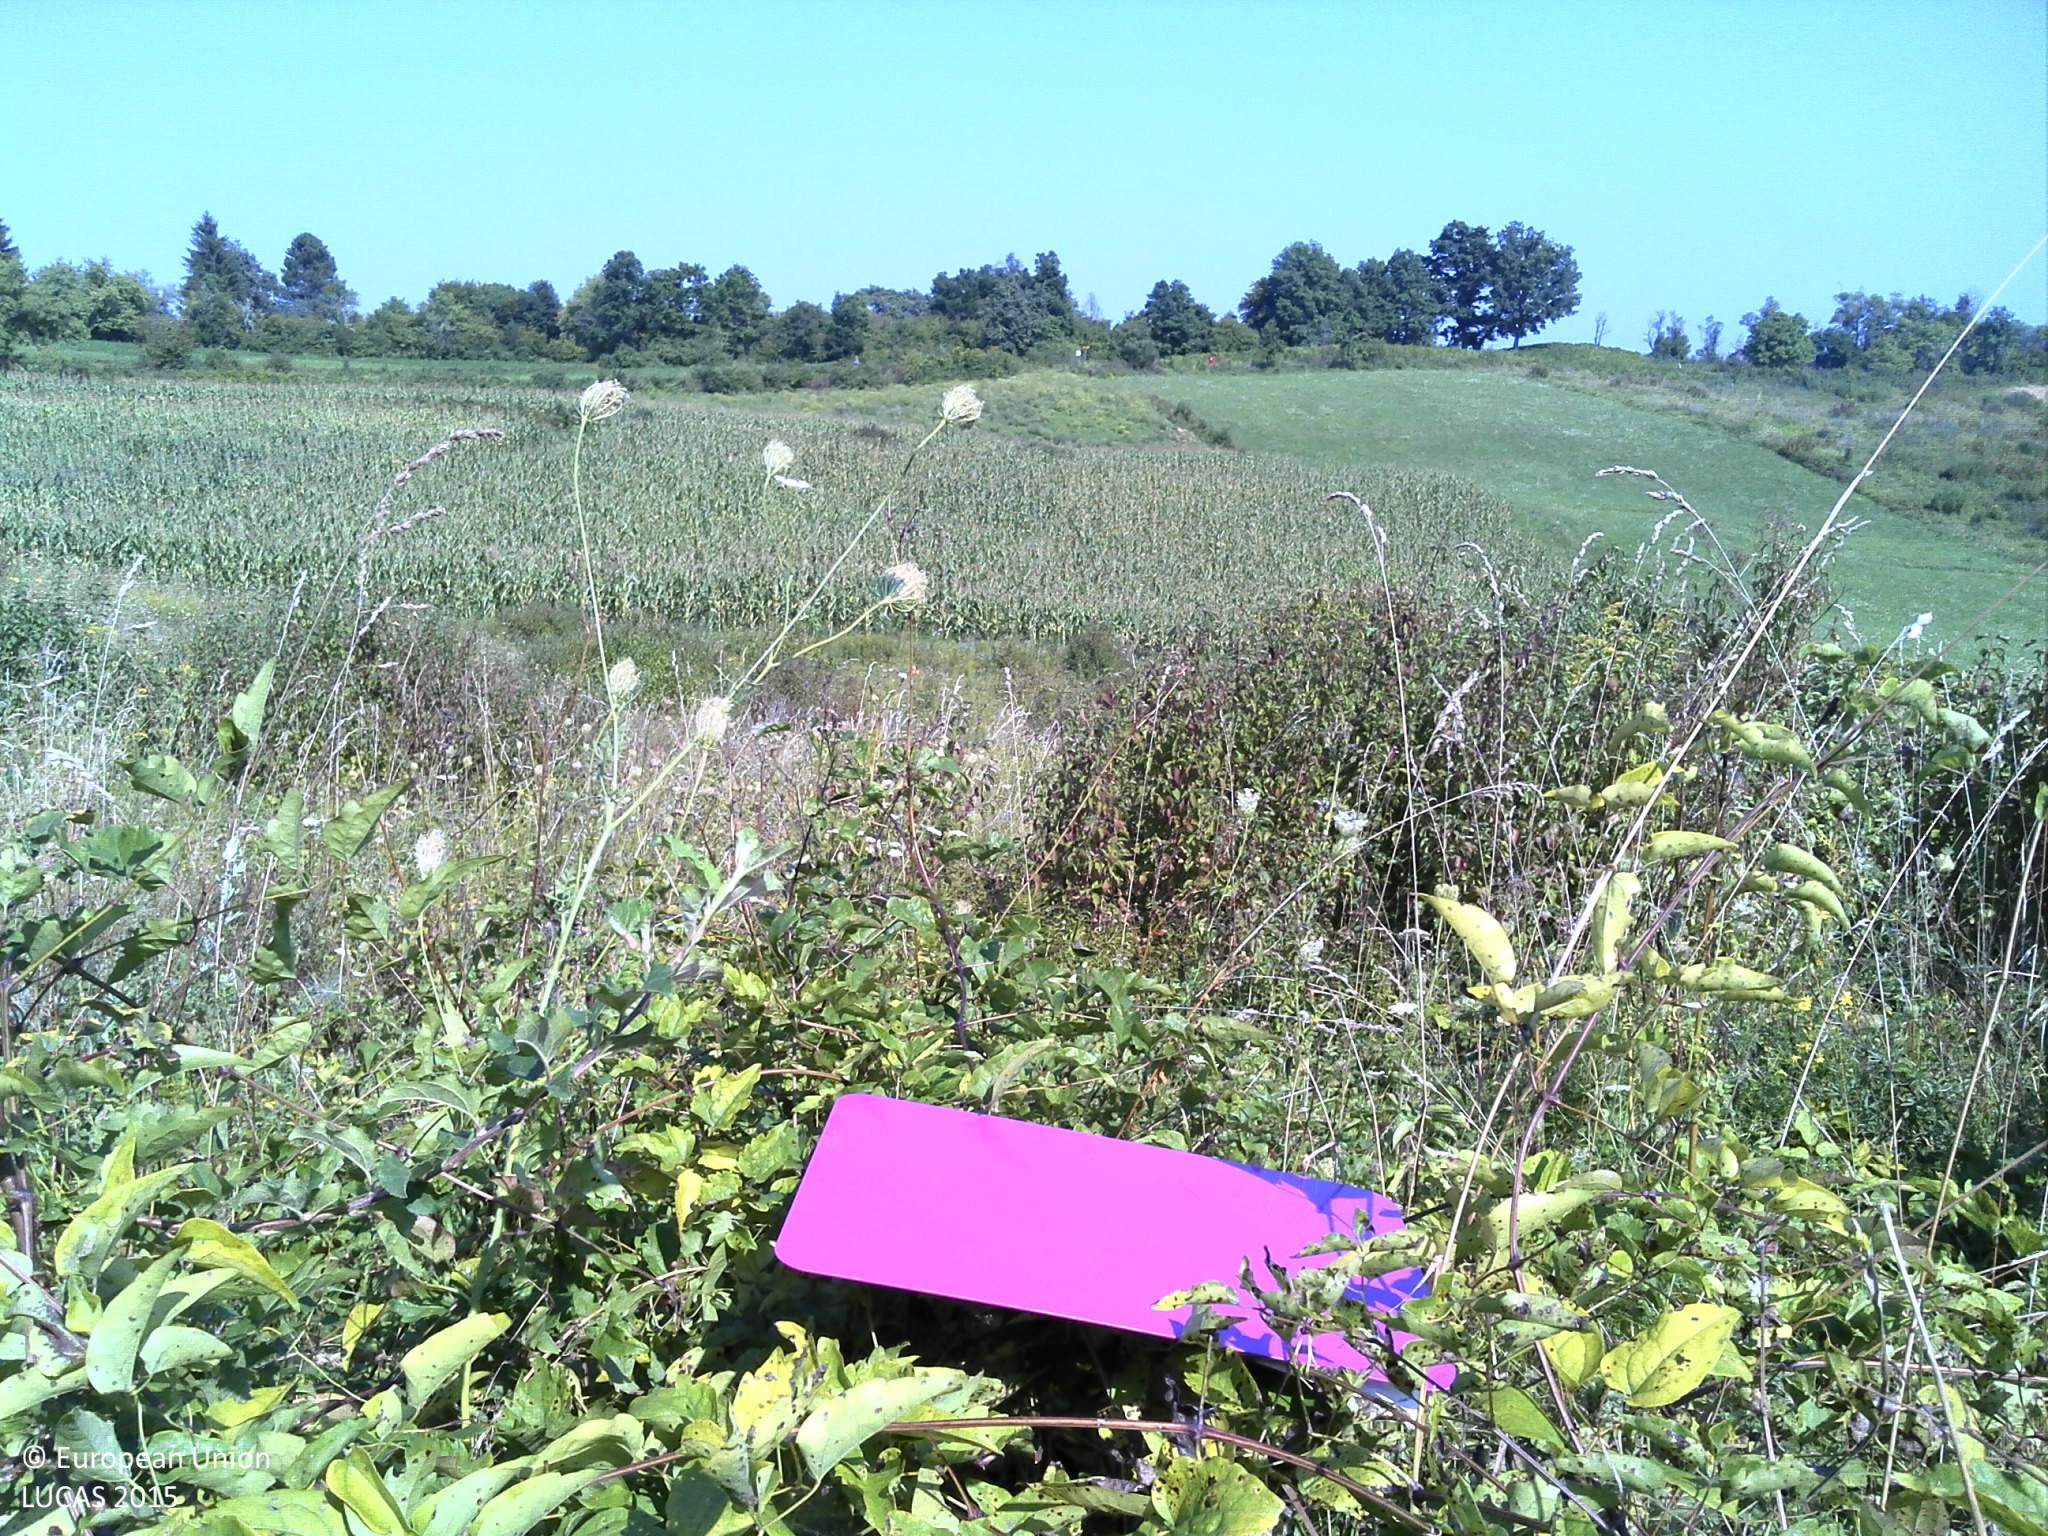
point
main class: Grassland
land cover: Spontaneously vegetated surfaces
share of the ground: > 75 %
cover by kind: herbaceous plants 100 %
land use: Semi-natural and natural areas not in use
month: August
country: HR
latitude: 45.1853
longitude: 16.3731
